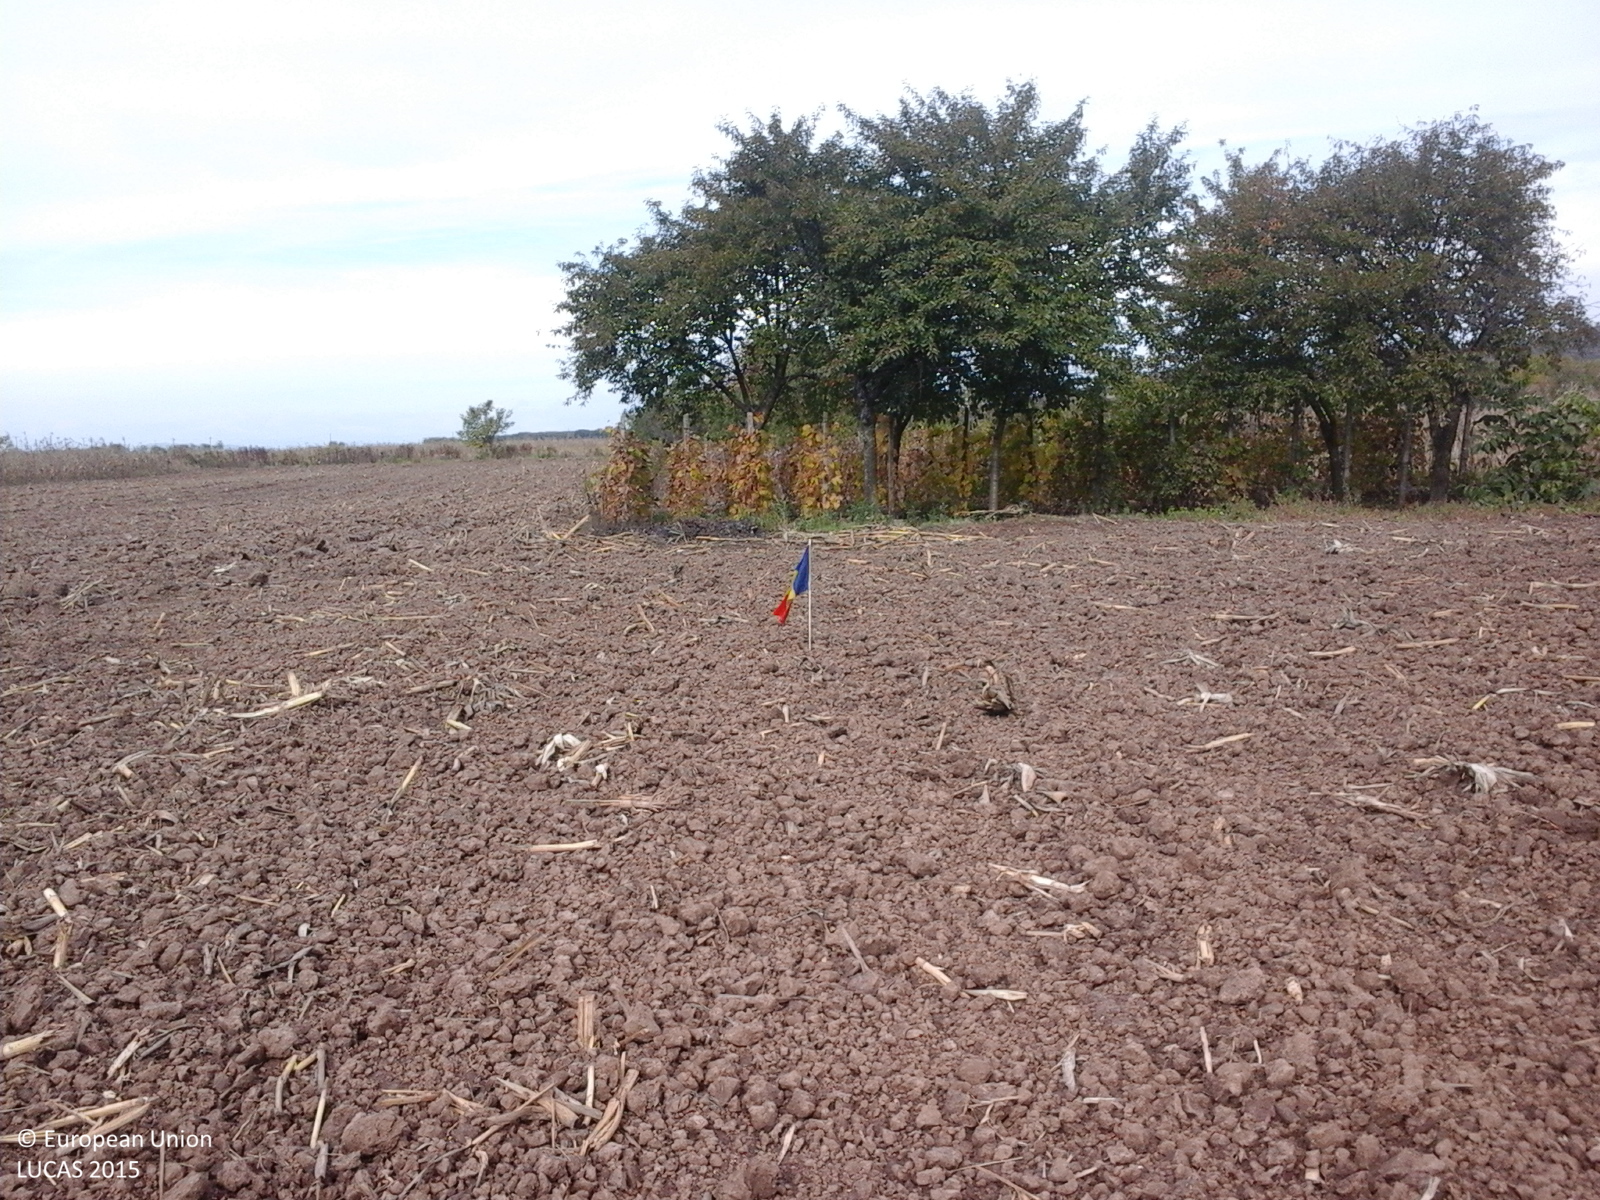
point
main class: Cropland
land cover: Maize
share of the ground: < 10 %
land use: Agriculture (excluding fallow land and kitchen gardens)
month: October
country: RO
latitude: 44.9998
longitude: 26.0556
